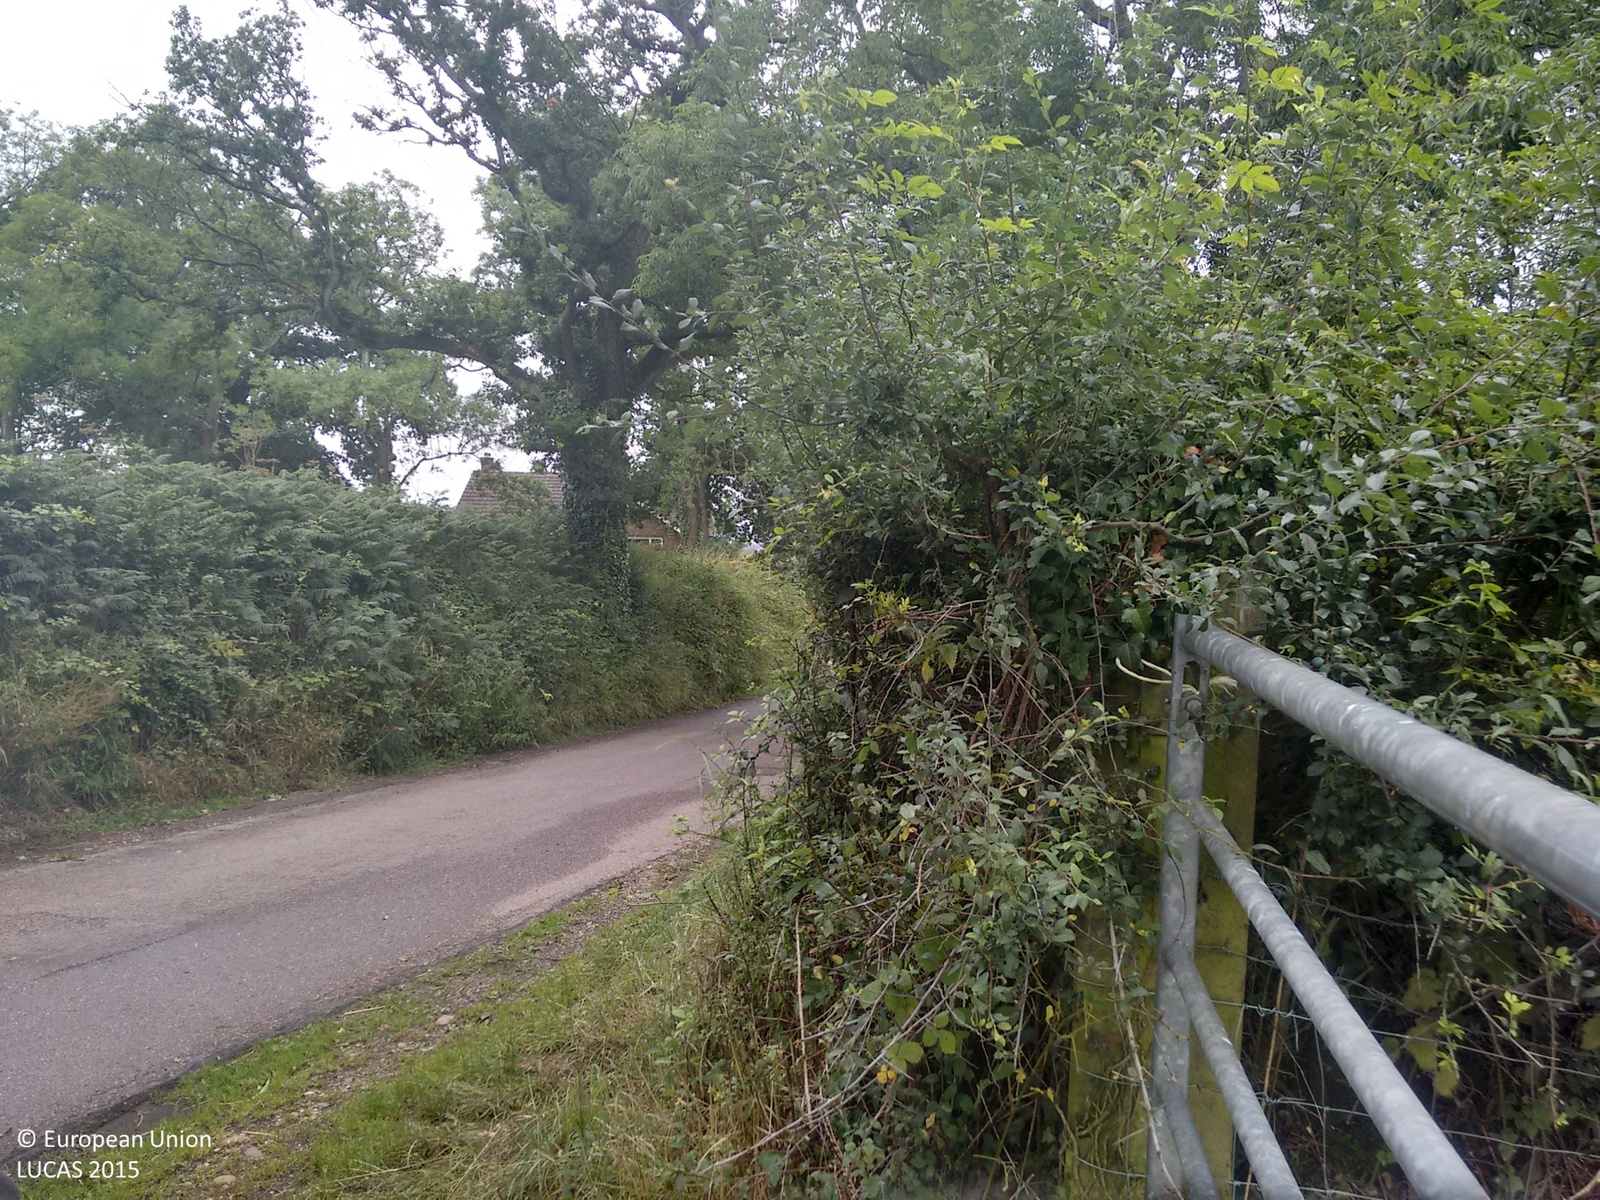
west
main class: Grassland
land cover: Grassland without tree/shrub cover
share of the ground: > 75 %
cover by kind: herbaceous plants 100 %
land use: Agriculture (excluding fallow land and kitchen gardens)
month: July
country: GB
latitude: 50.7636
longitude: -3.3369
